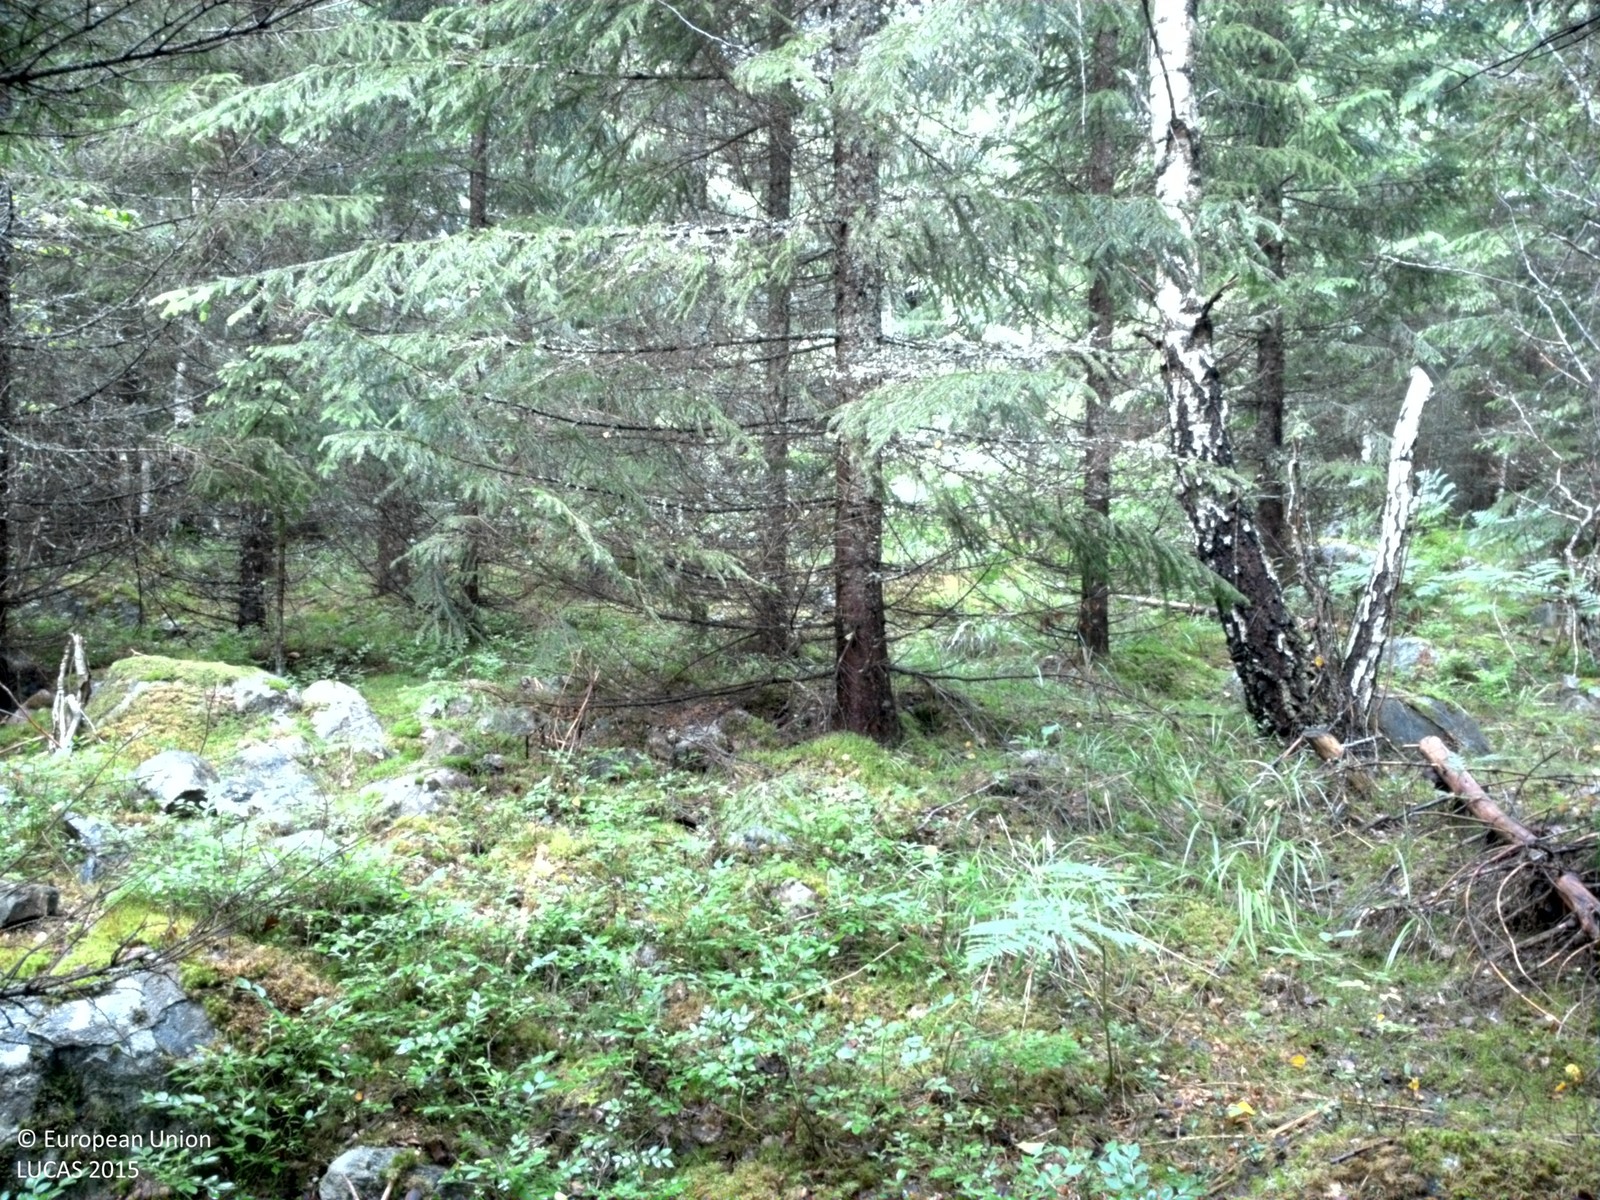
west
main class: Woodland
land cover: Spruce dominated coniferous woodland
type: boreal forest
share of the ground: > 75 %
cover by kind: coniferous forest trees 65 %, lichens and mosses 20 %, broadleaved forest trees 10 %, herbaceous plants 5 %
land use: Forestry
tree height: > 5 m
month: July
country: SE
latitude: 59.8955
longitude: 18.6679
